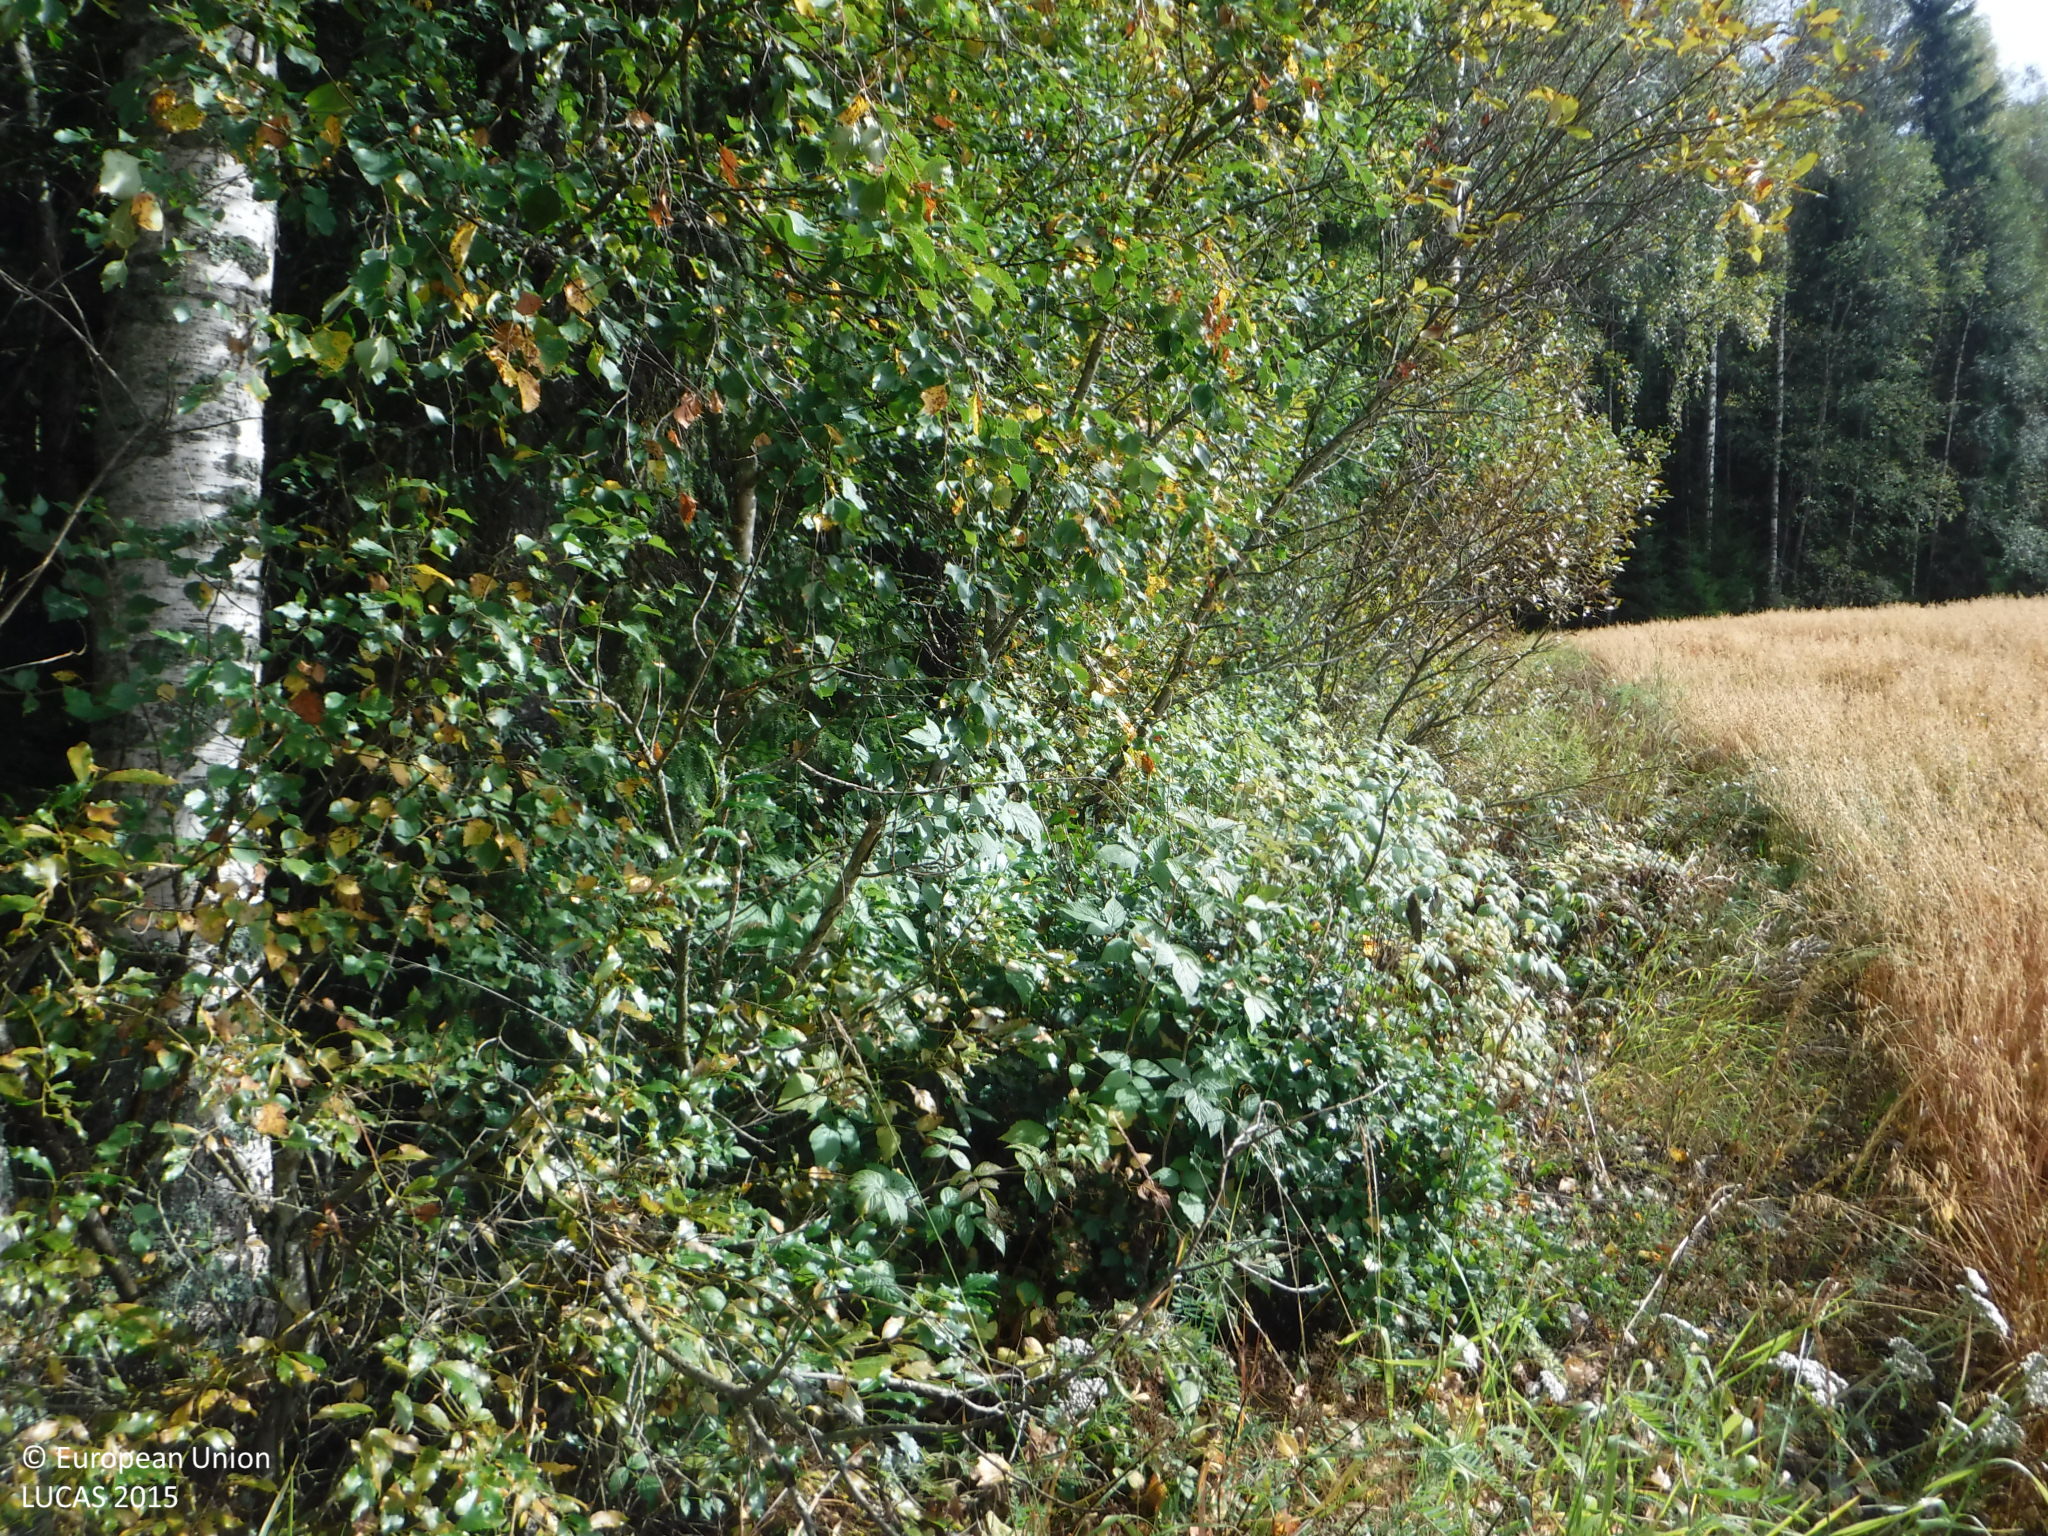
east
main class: Cropland
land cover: Oats
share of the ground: > 75 %
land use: Agriculture (excluding fallow land and kitchen gardens)
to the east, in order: Oats; Grass margins; Groves; Spruce dominated mixed woodland; Ditches and canals; Spruce dominated coniferous woodland; Tracks; Ditches and canals; Spruce dominated coniferous woodland; Ditches and canals; Tracks; Spruce dominated coniferous woodland
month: September
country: FI
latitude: 61.3341
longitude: 23.1749
